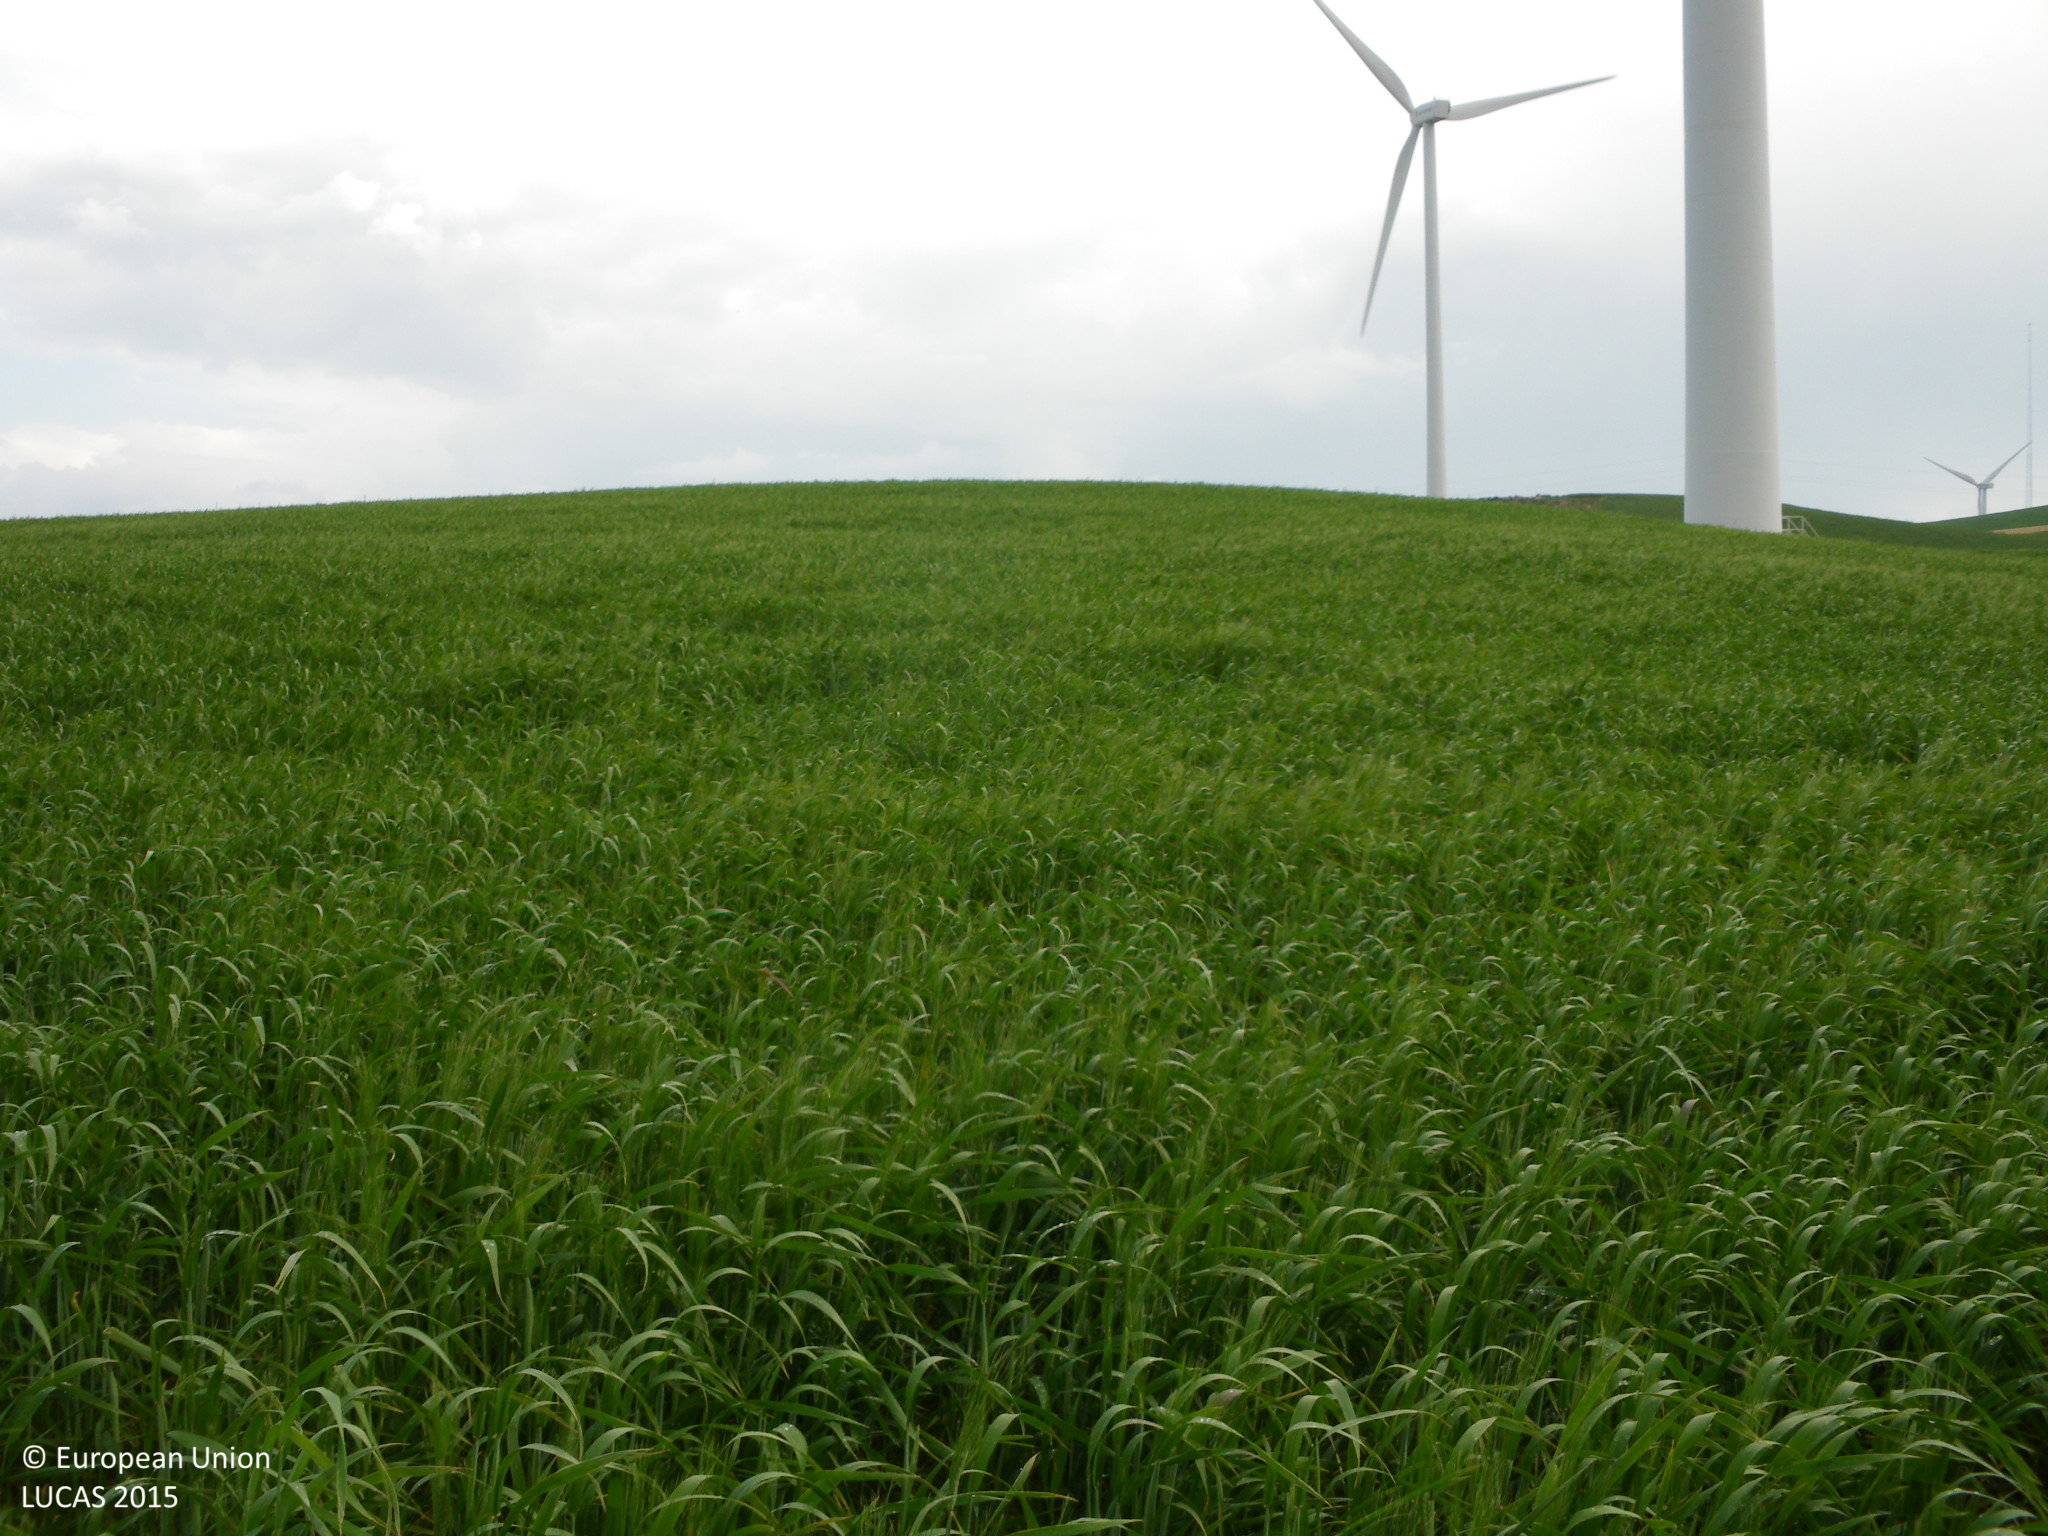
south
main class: Cropland
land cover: Durum wheat
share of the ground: > 75 %
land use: Agriculture (excluding fallow land and kitchen gardens)
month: April
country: ES
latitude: 36.4766
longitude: -5.8863
